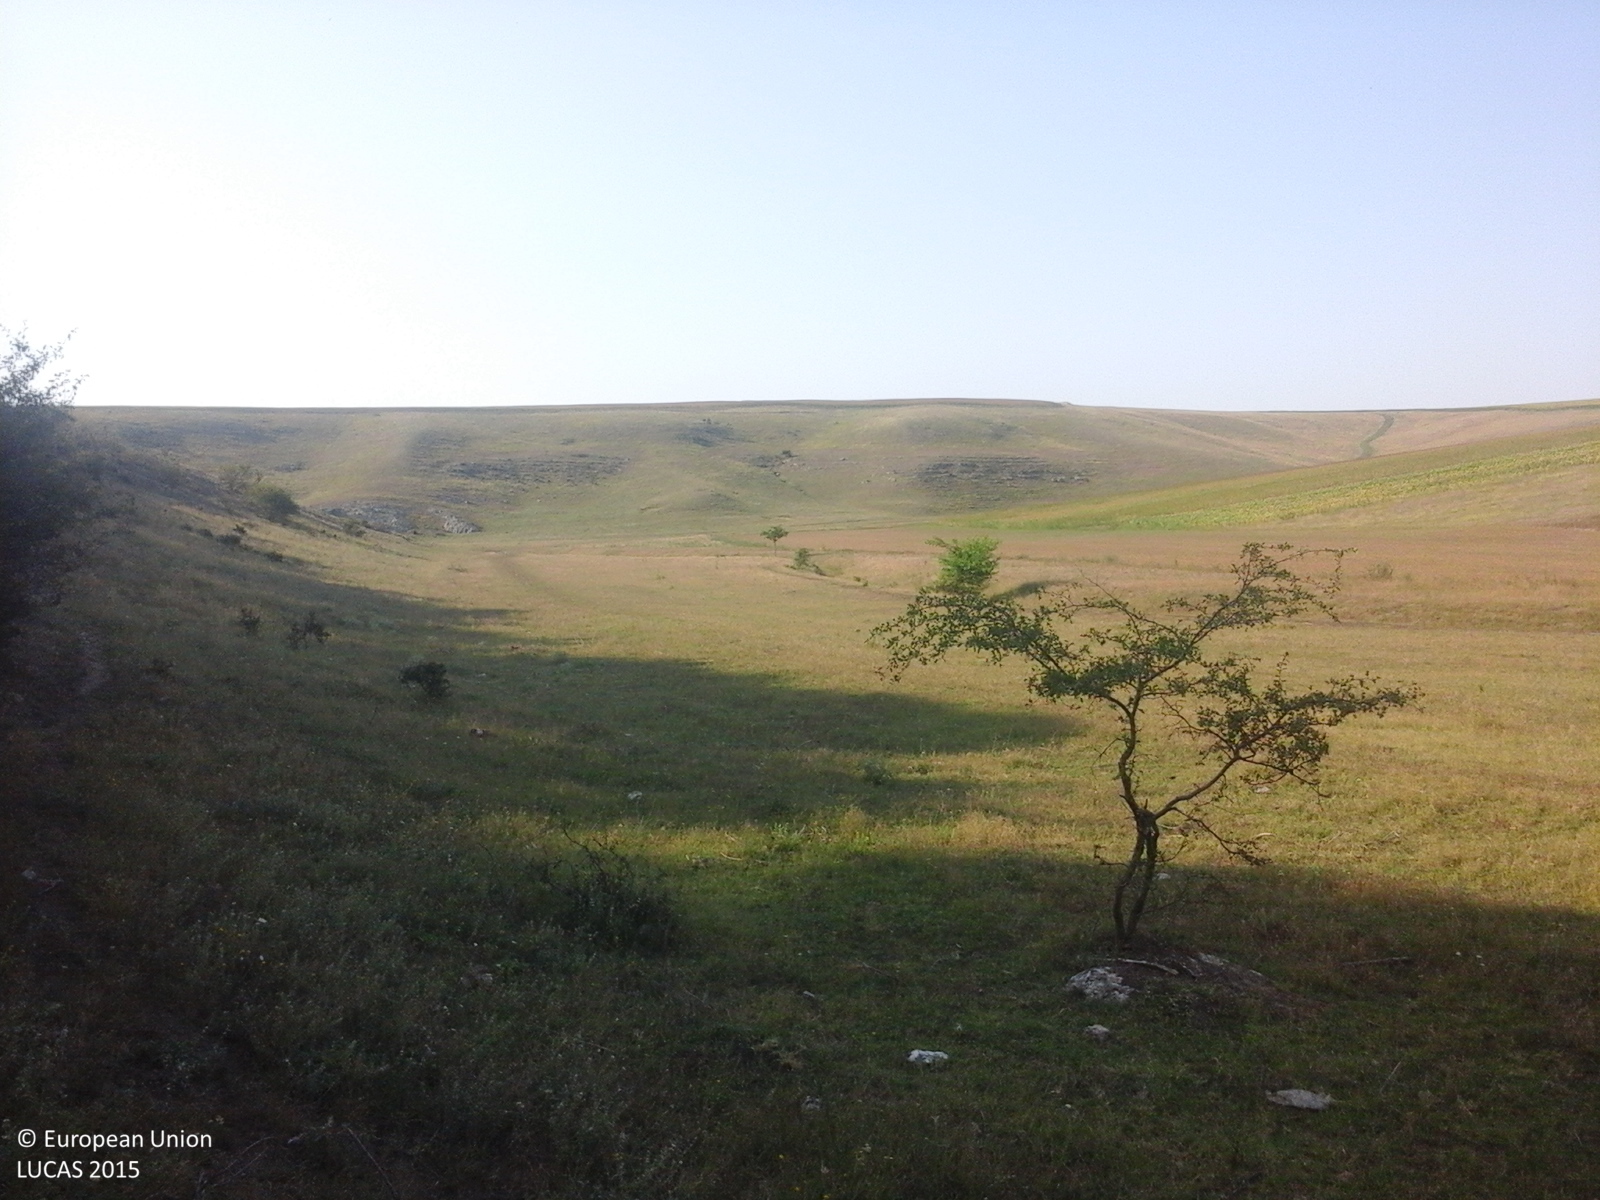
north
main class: Grassland
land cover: Grassland with sparse tree/shrub cover
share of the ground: > 75 %
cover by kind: herbaceous plants 95 %, broadleaved forest trees 5 %
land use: Semi-natural and natural areas not in use
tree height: < 5 m
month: August
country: RO
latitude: 44.1191
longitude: 28.0361
